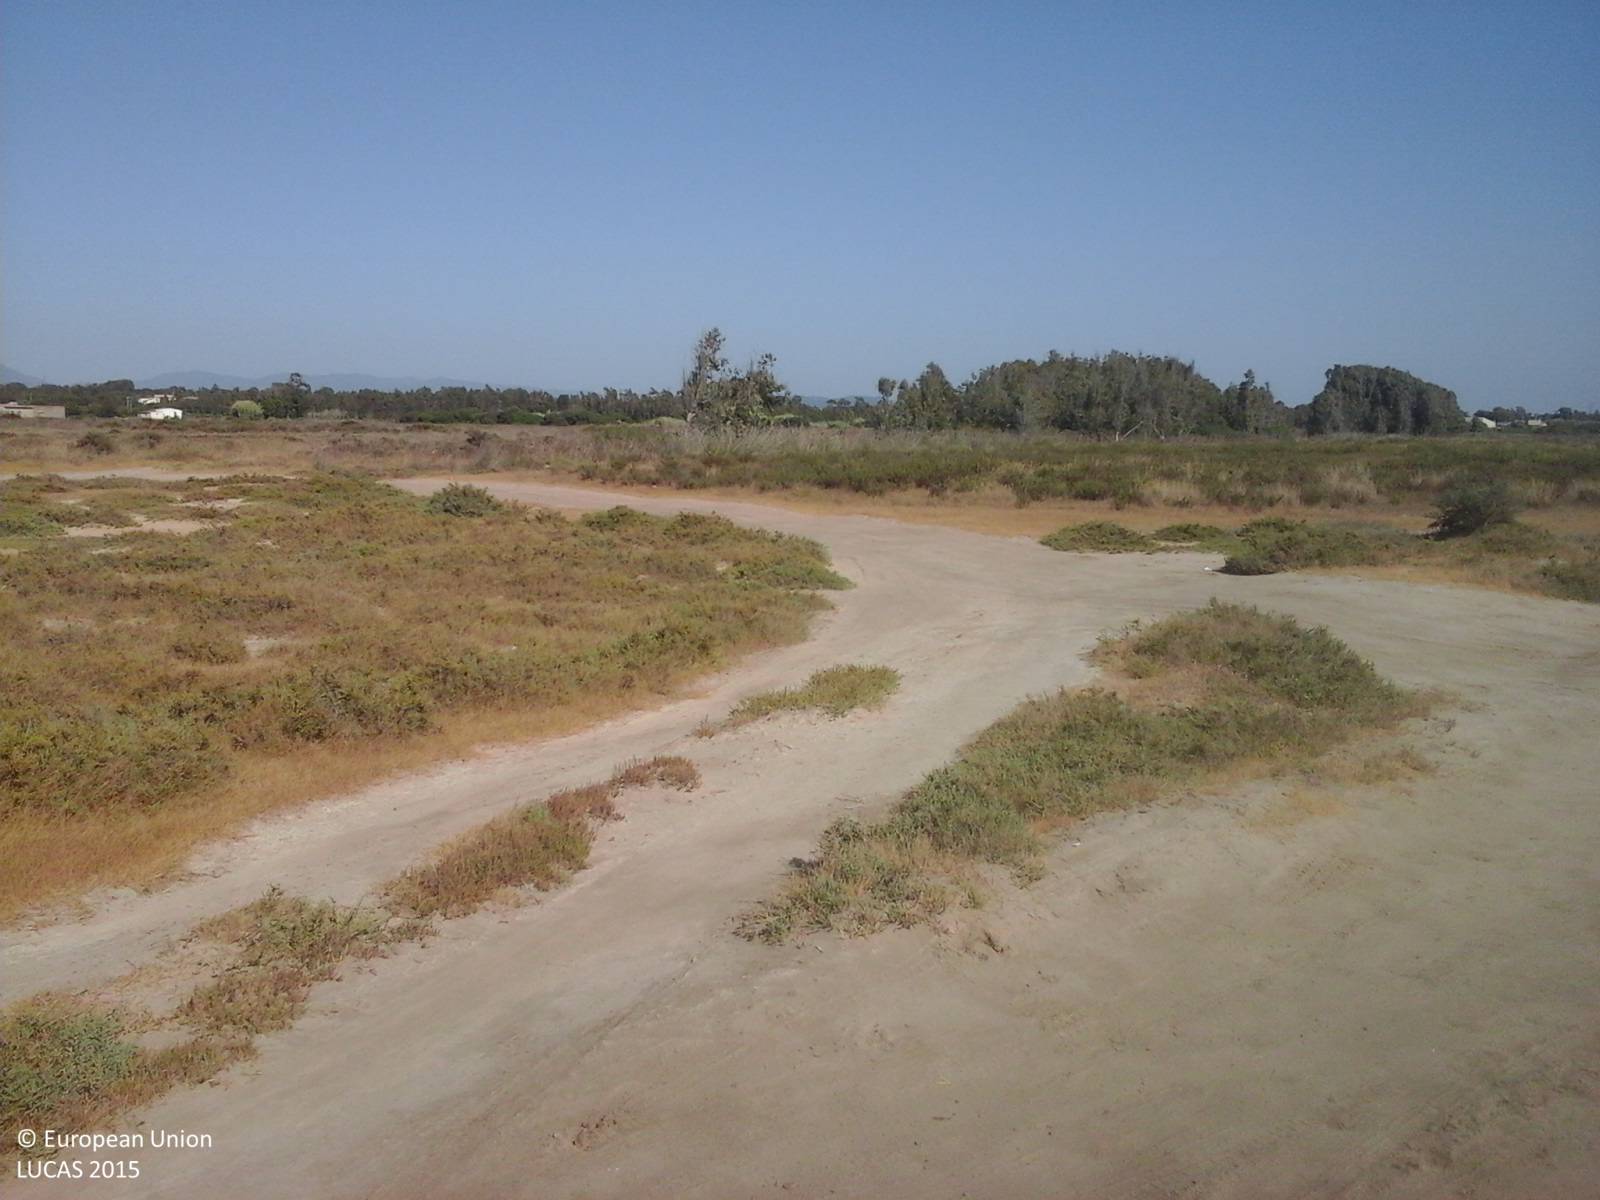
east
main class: Grassland
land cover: Grassland without tree/shrub cover
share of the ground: > 75 %
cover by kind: herbaceous plants 90 %, unconsolidated bare surface 10 %
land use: Semi-natural and natural areas not in use
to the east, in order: Grassland without tree/shrub cover; Tracks; Grassland without tree/shrub cover; Tracks; Grassland without tree/shrub cover
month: July
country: IT
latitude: 39.1141
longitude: 8.4714
